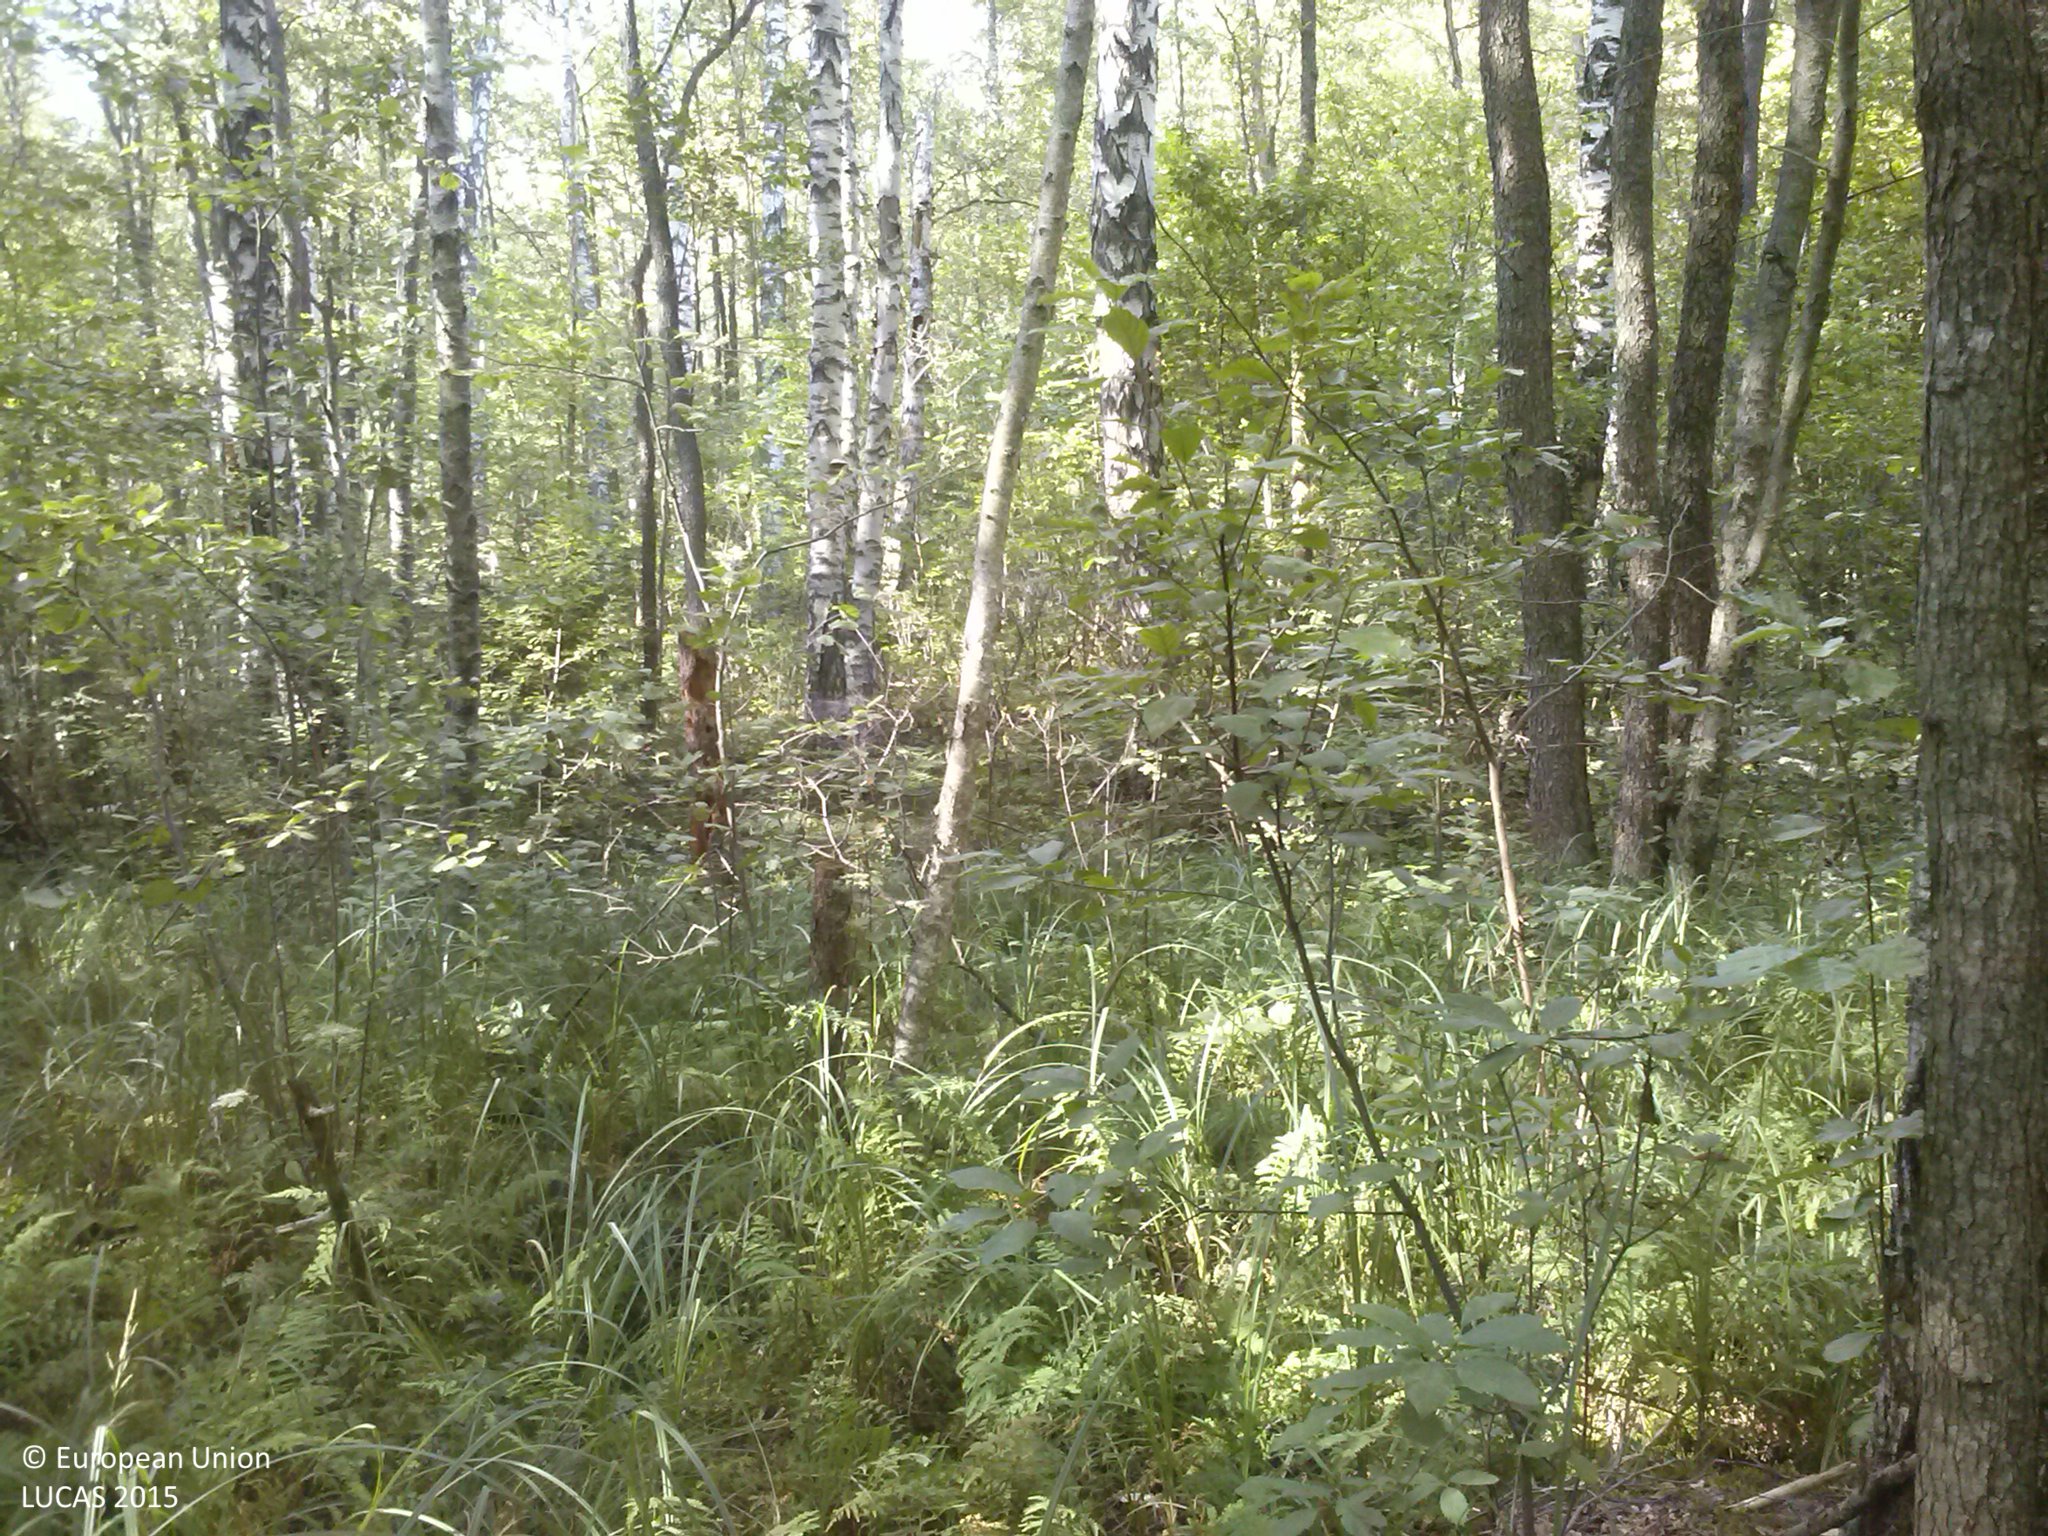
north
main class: Woodland
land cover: Broadleaved woodland
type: non-riverine alder, birch or aspen forest
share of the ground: > 75 %
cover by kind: broadleaved forest trees 75 %, herbaceous plants 25 %
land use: Forestry
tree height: > 5 m
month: August
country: LV
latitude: 56.1651
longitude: 26.8596
